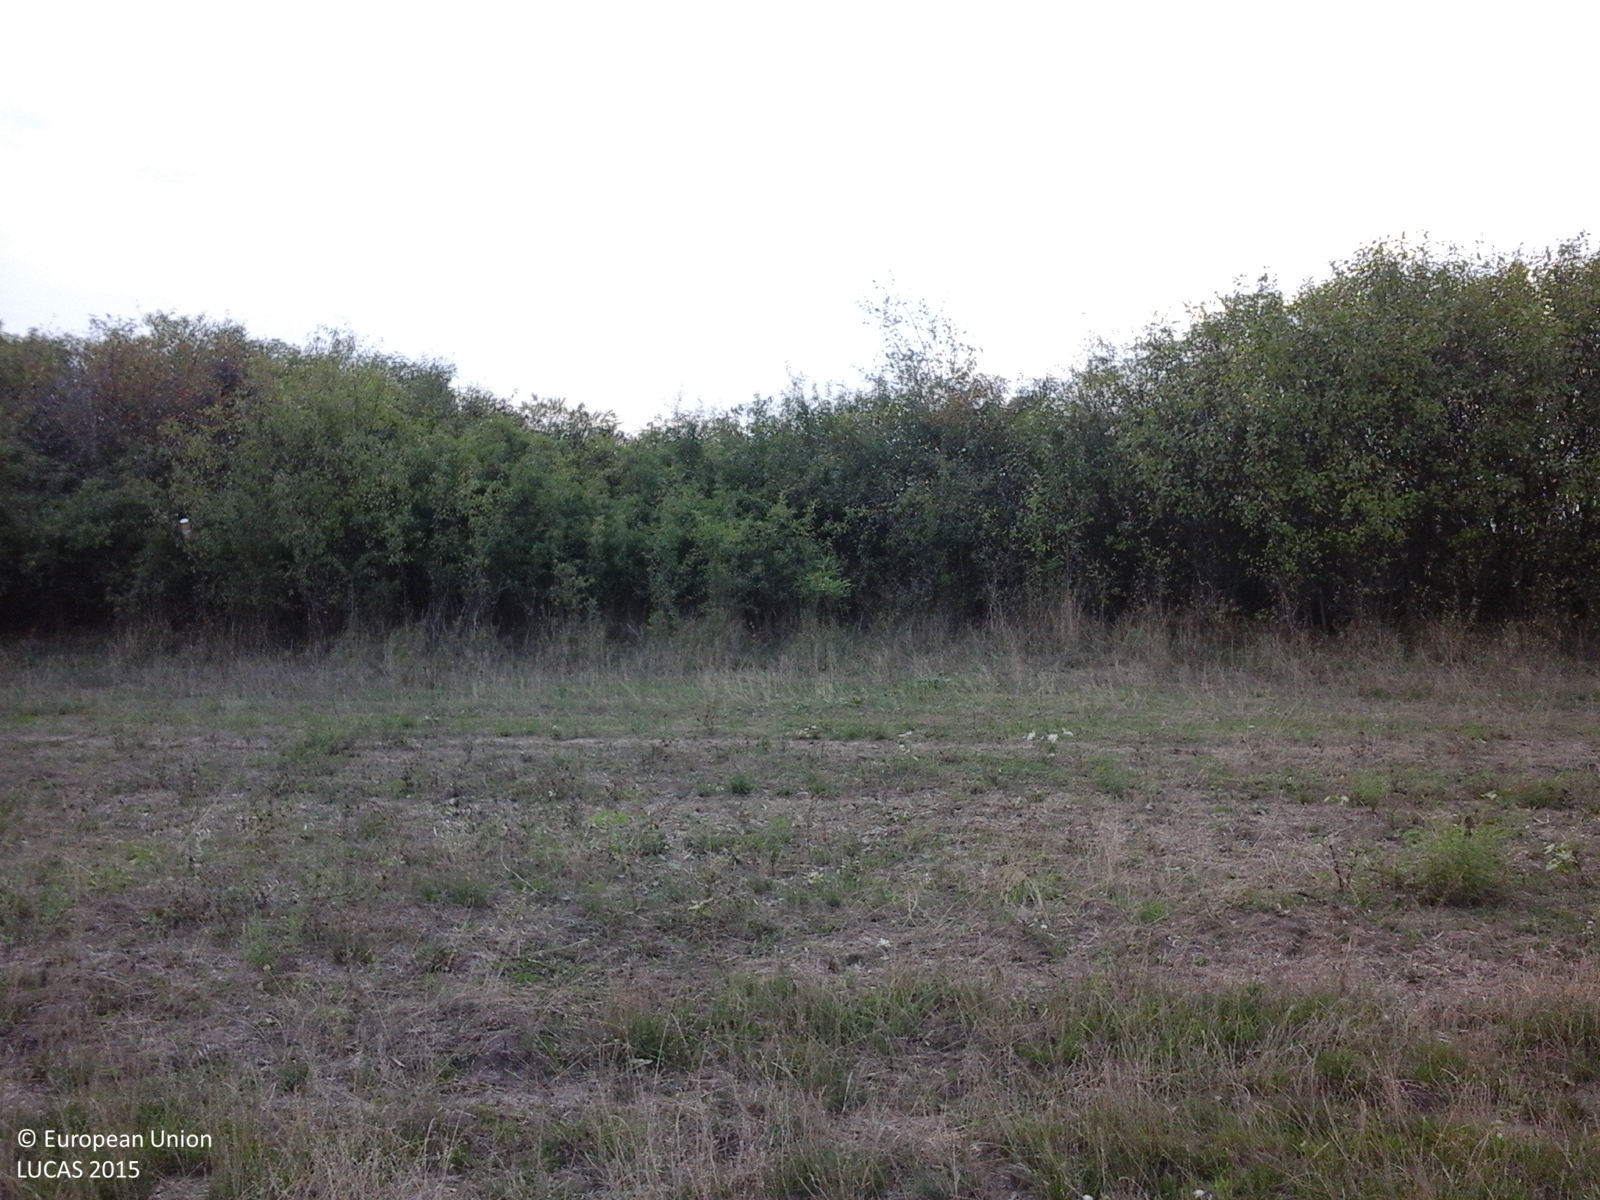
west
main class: Grassland
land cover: Spontaneously vegetated surfaces
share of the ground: > 75 %
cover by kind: herbaceous plants 90 %, consolidated bare surface 10 %
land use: Fallow land
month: August
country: RO
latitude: 46.0776
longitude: 21.6359
